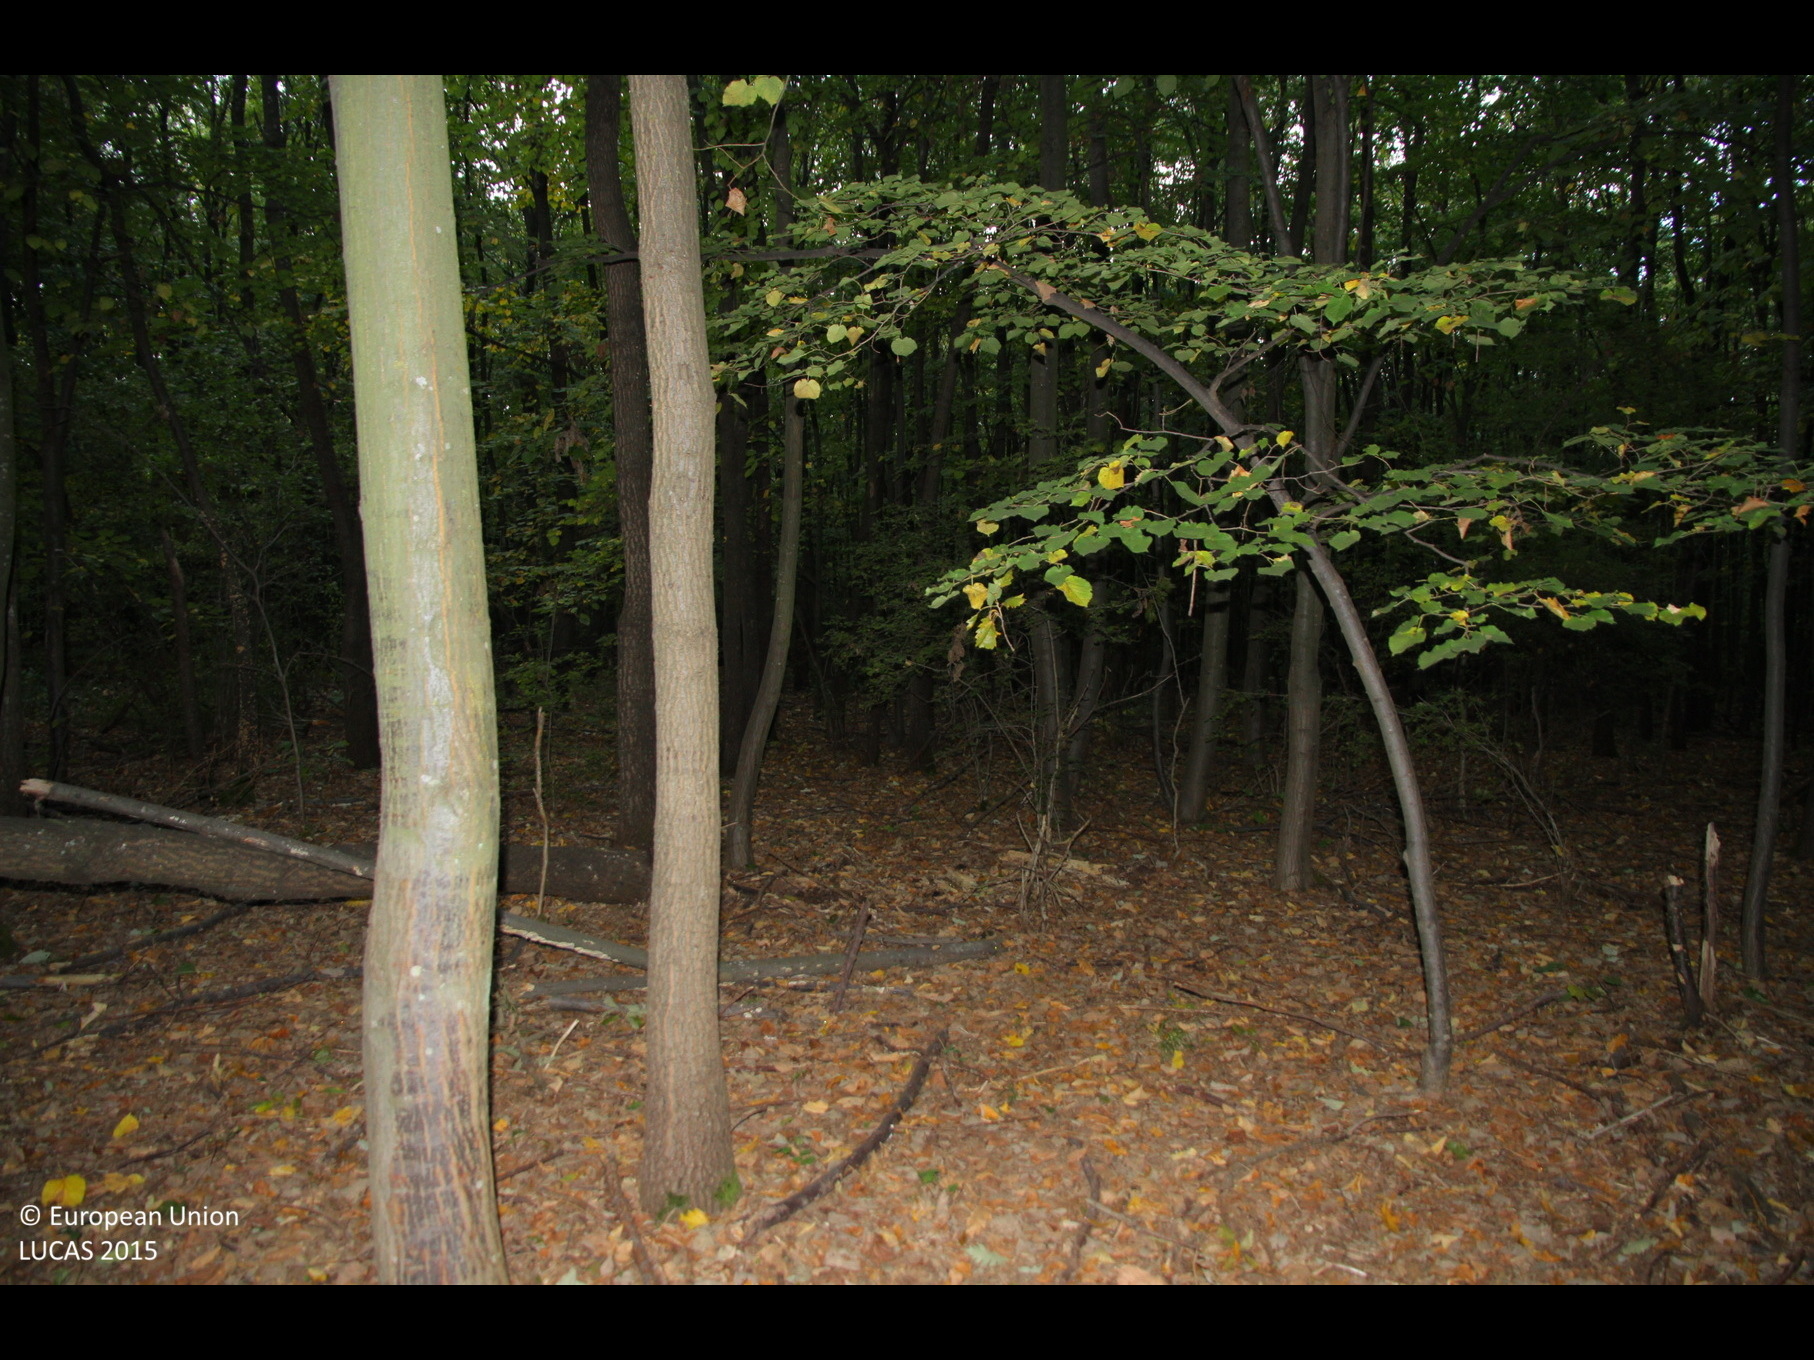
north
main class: Woodland
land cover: Broadleaved woodland
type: beech forest
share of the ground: > 75 %
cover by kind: broadleaved forest trees 100 %
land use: Forestry
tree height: > 5 m
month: October
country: BG
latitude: 43.5470
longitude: 27.1911
